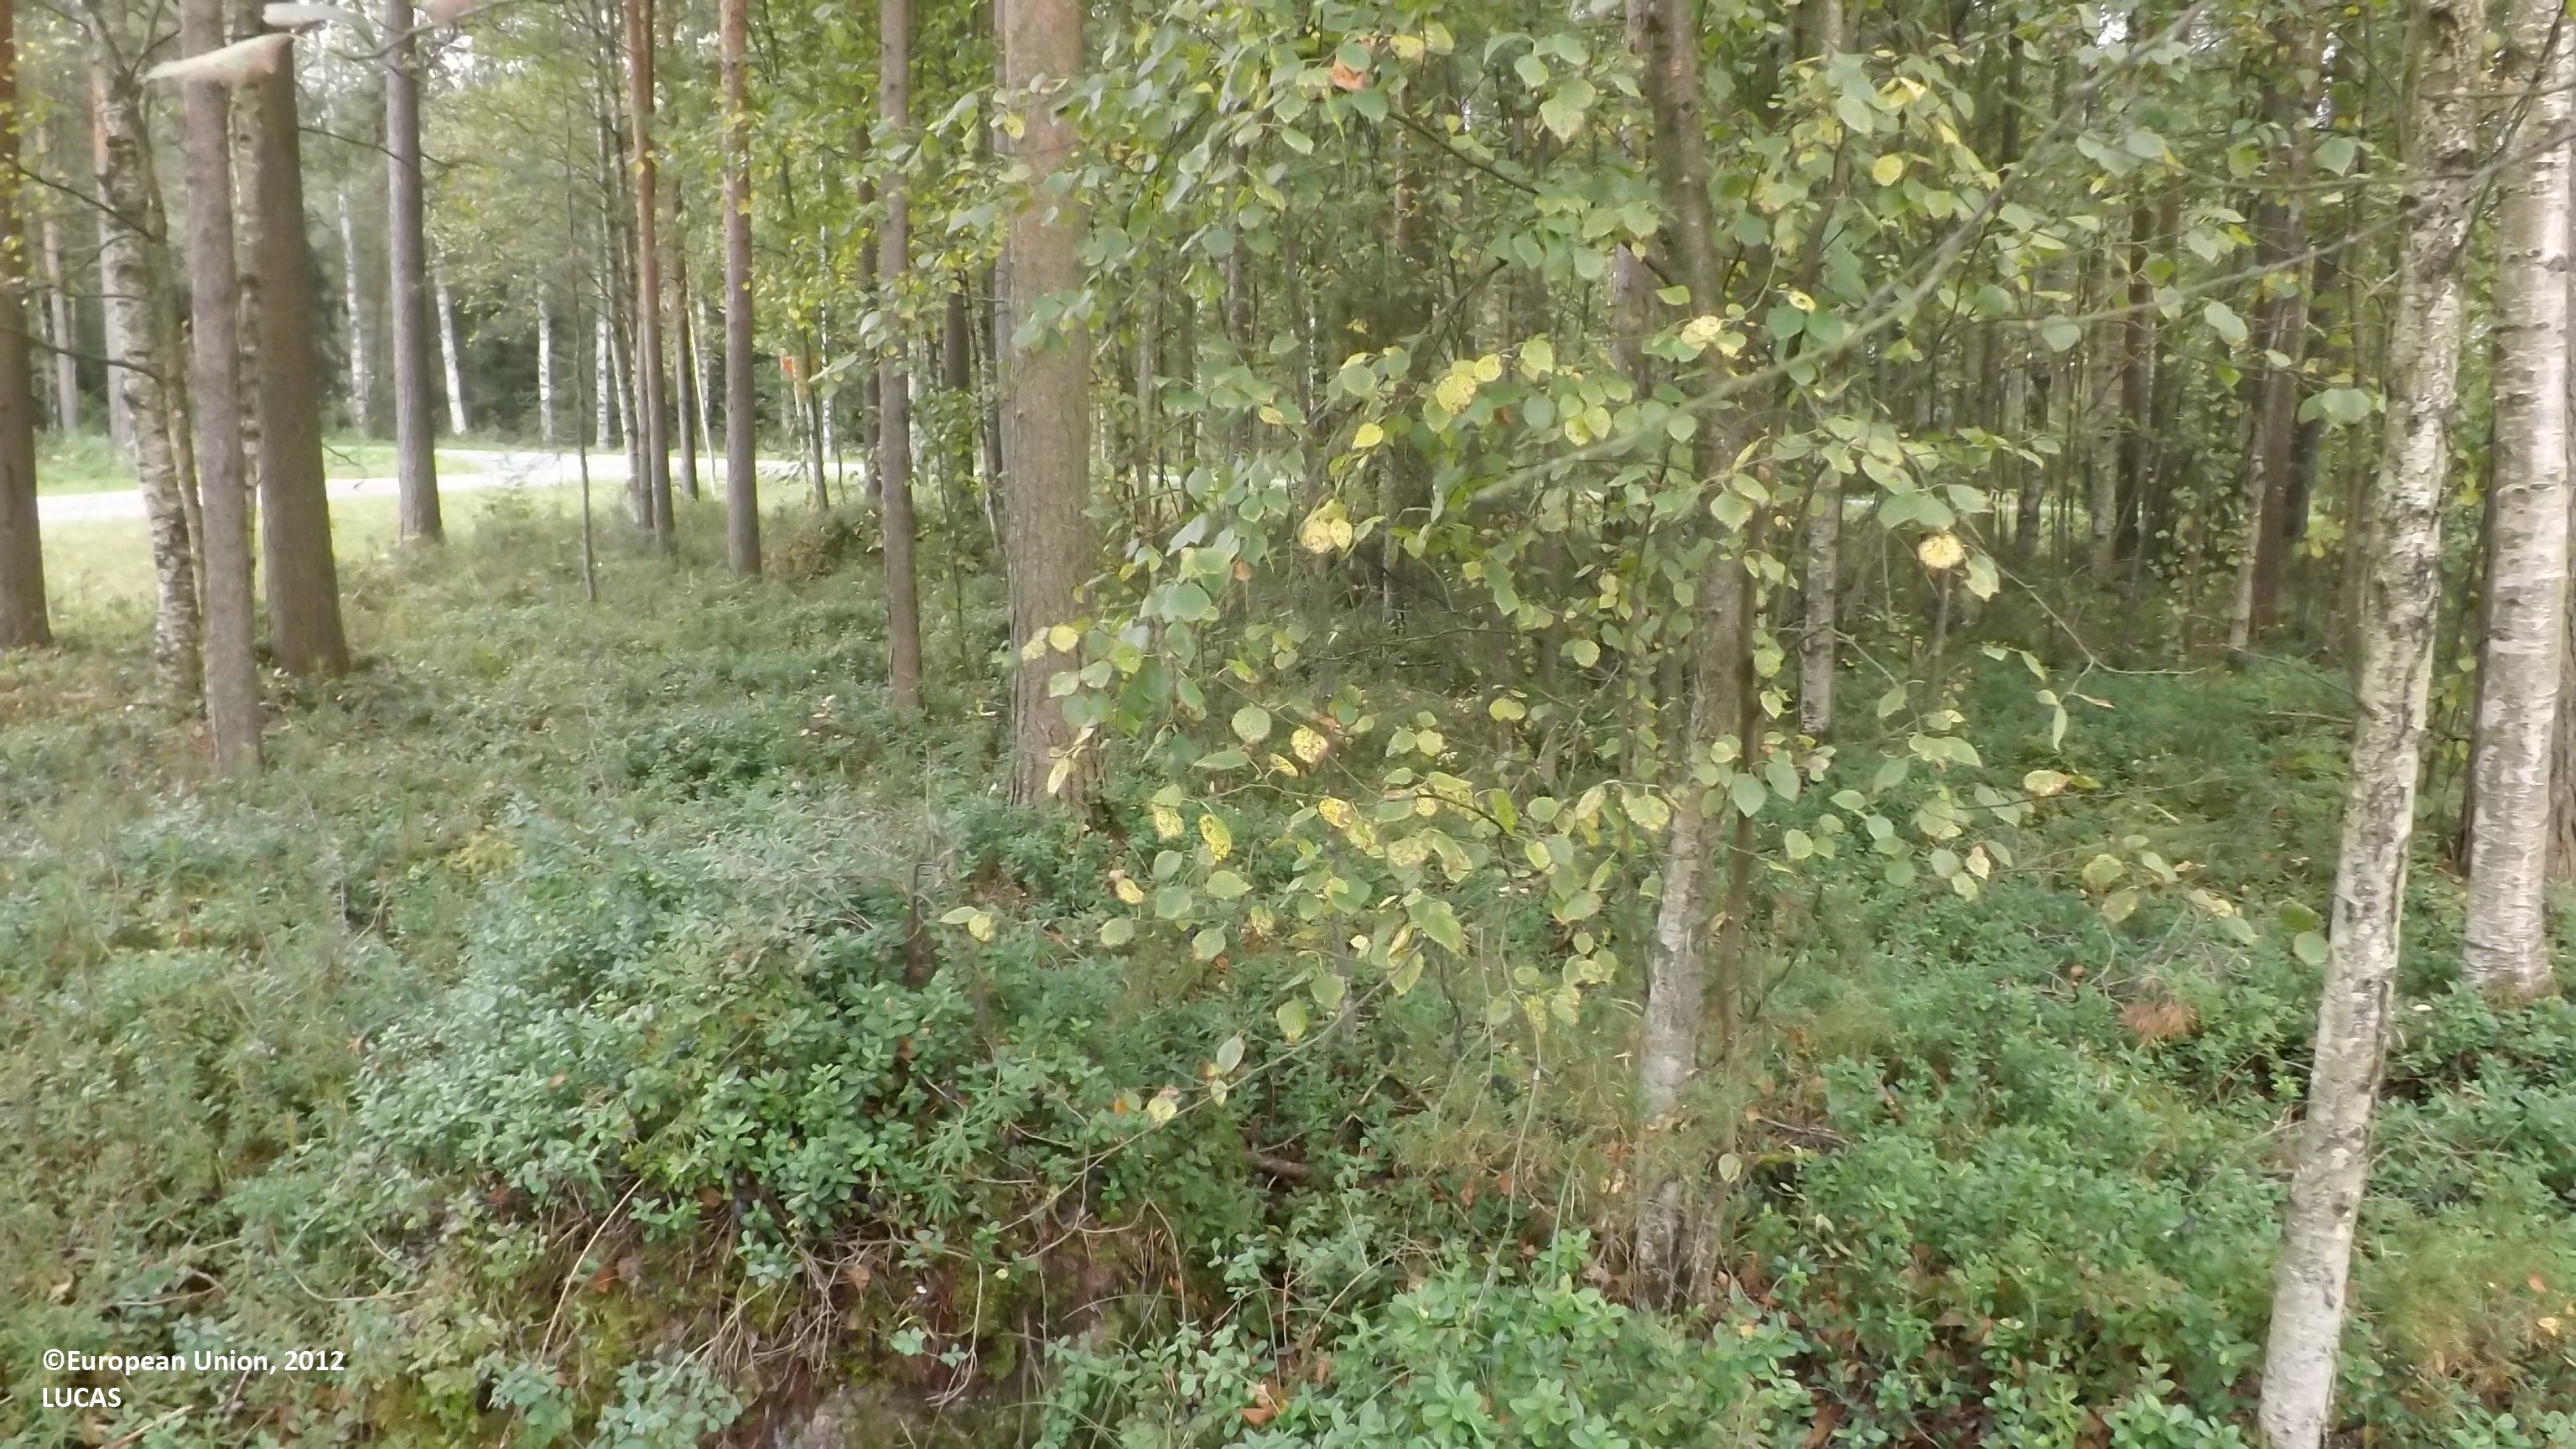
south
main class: Woodland
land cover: Pine dominated coniferous woodland
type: boreal forest
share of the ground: 50 - 75 %
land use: Forestry
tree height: > 5 m
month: August
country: FI
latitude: 63.8970
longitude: 23.8550
